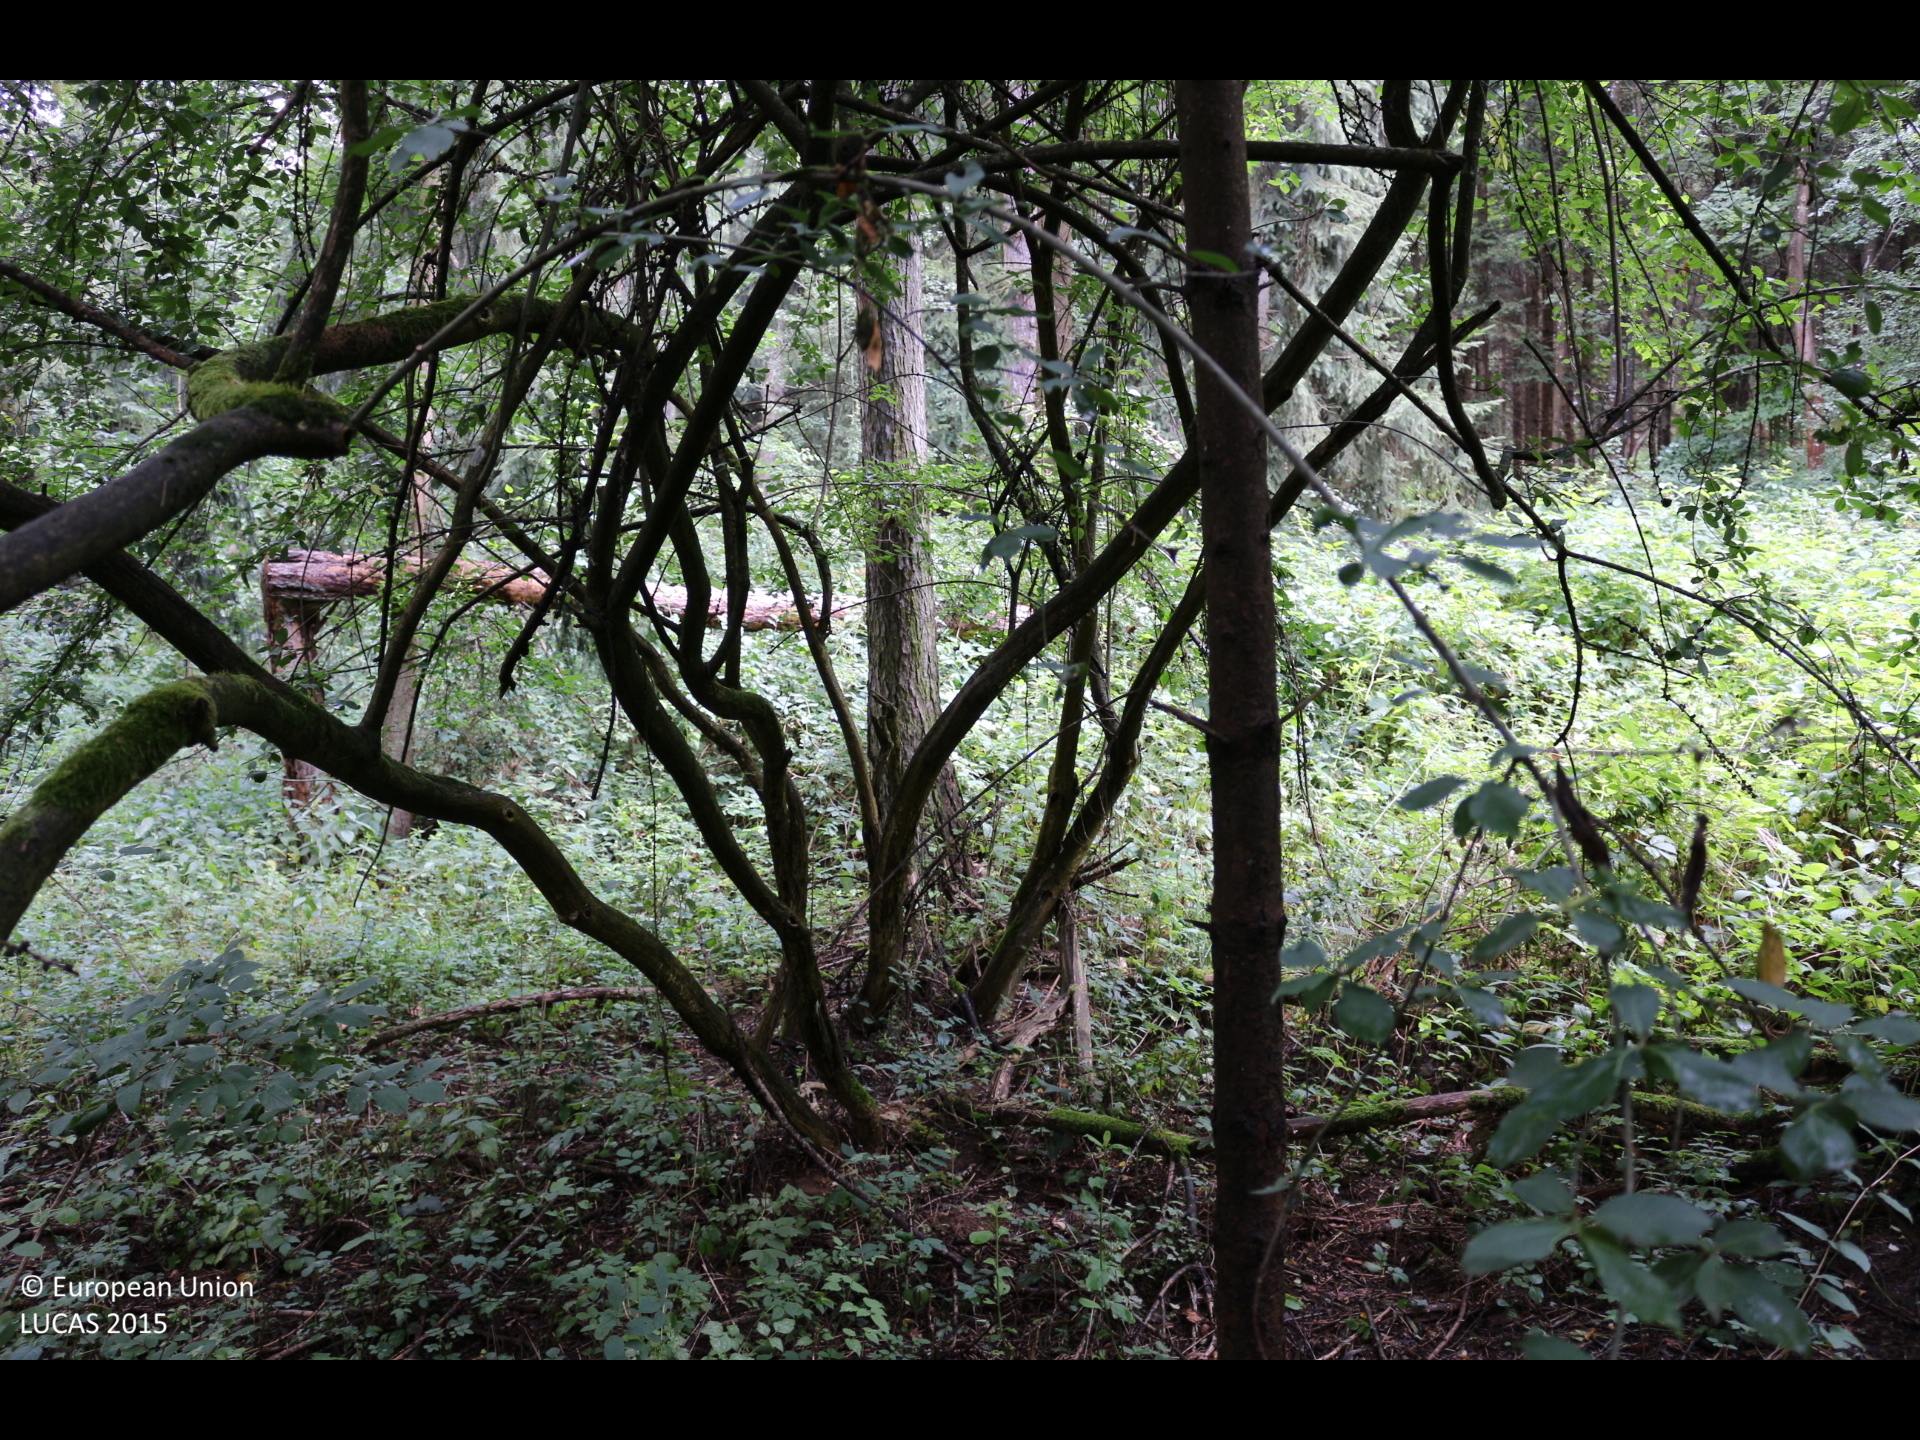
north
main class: Woodland
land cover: Spruce dominated mixed woodland
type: alpine coniferous forest
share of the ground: > 75 %
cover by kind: coniferous forest trees 40 %, broadleaved forest trees 40 %, shrubs 10 %, herbaceous plants 10 %
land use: Forestry
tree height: > 5 m
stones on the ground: < 10 %
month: July
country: AT
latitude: 46.8530
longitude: 14.4703
